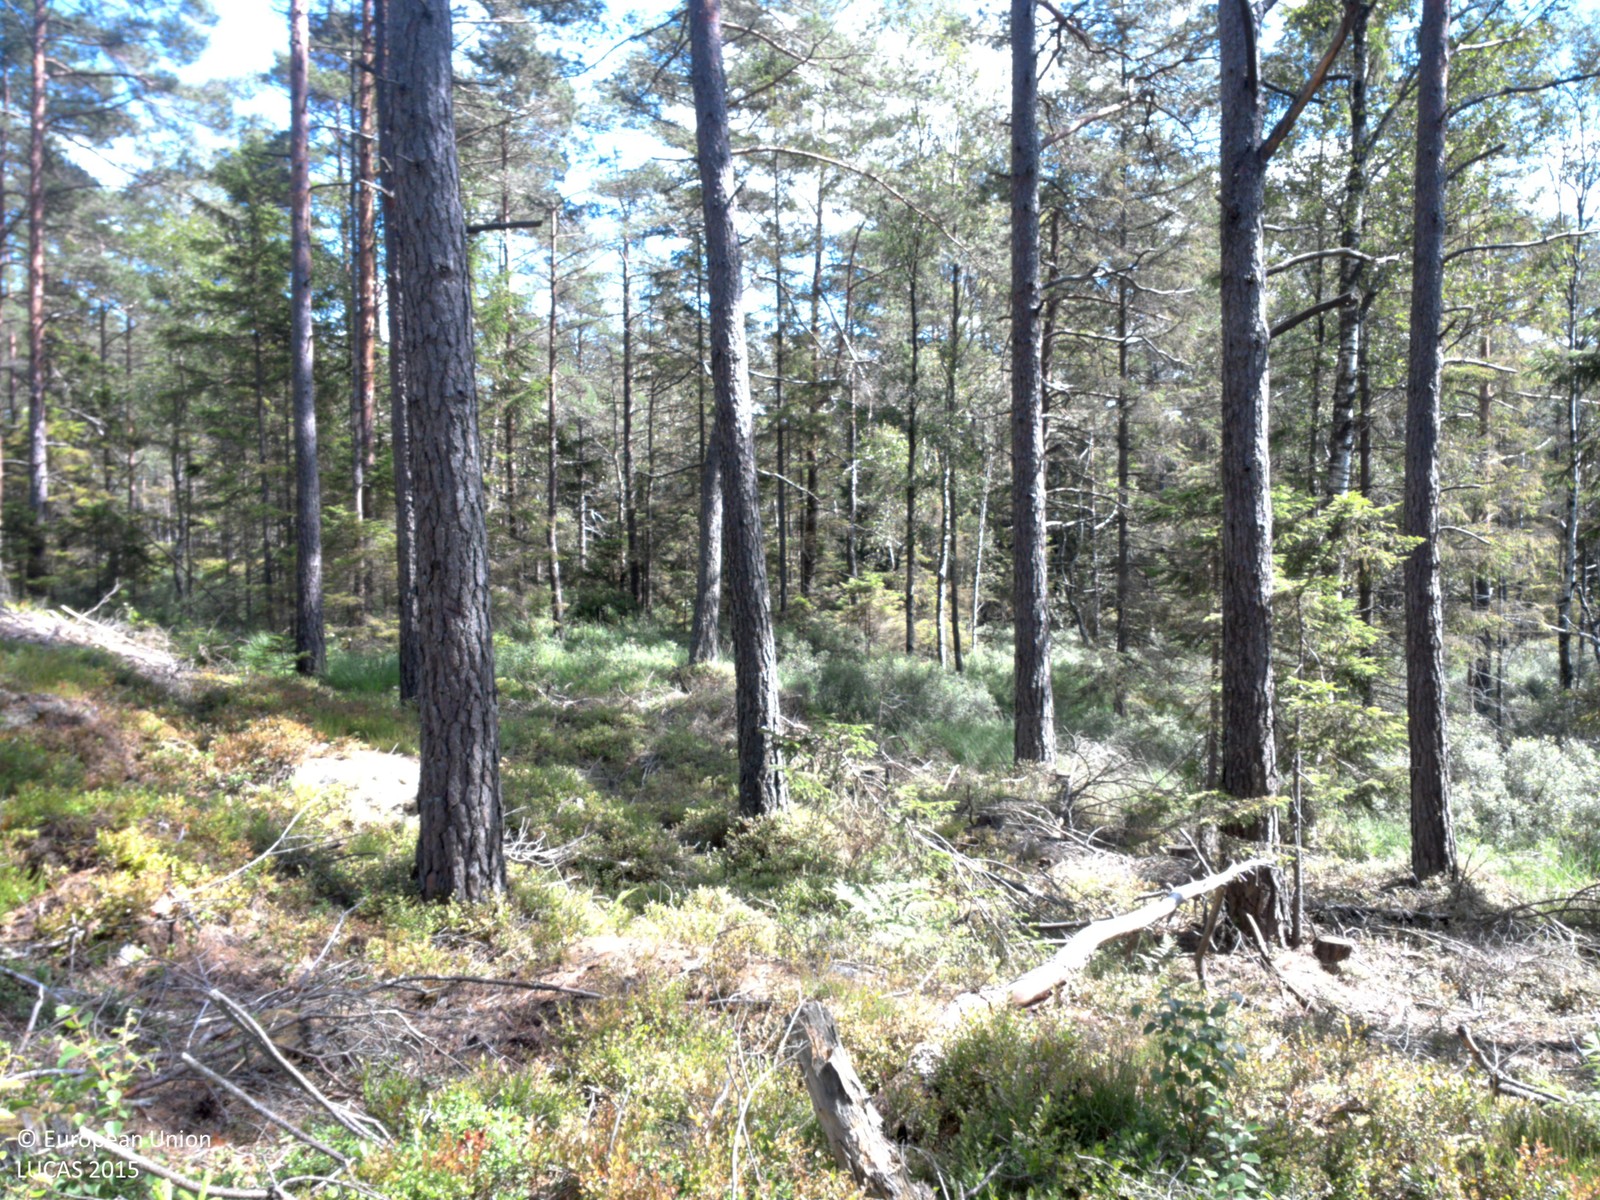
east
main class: Woodland
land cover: Pine dominated coniferous woodland
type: boreal forest
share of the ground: 50 - 75 %
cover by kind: coniferous forest trees 45 %, shrubs 25 %, lichens and mosses 25 %, broadleaved forest trees 5 %
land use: Forestry
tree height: > 5 m
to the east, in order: Pine dominated coniferous woodland; Pine dominated mixed woodland; Pine dominated coniferous woodland
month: July
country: SE
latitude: 58.5672
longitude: 11.8013
